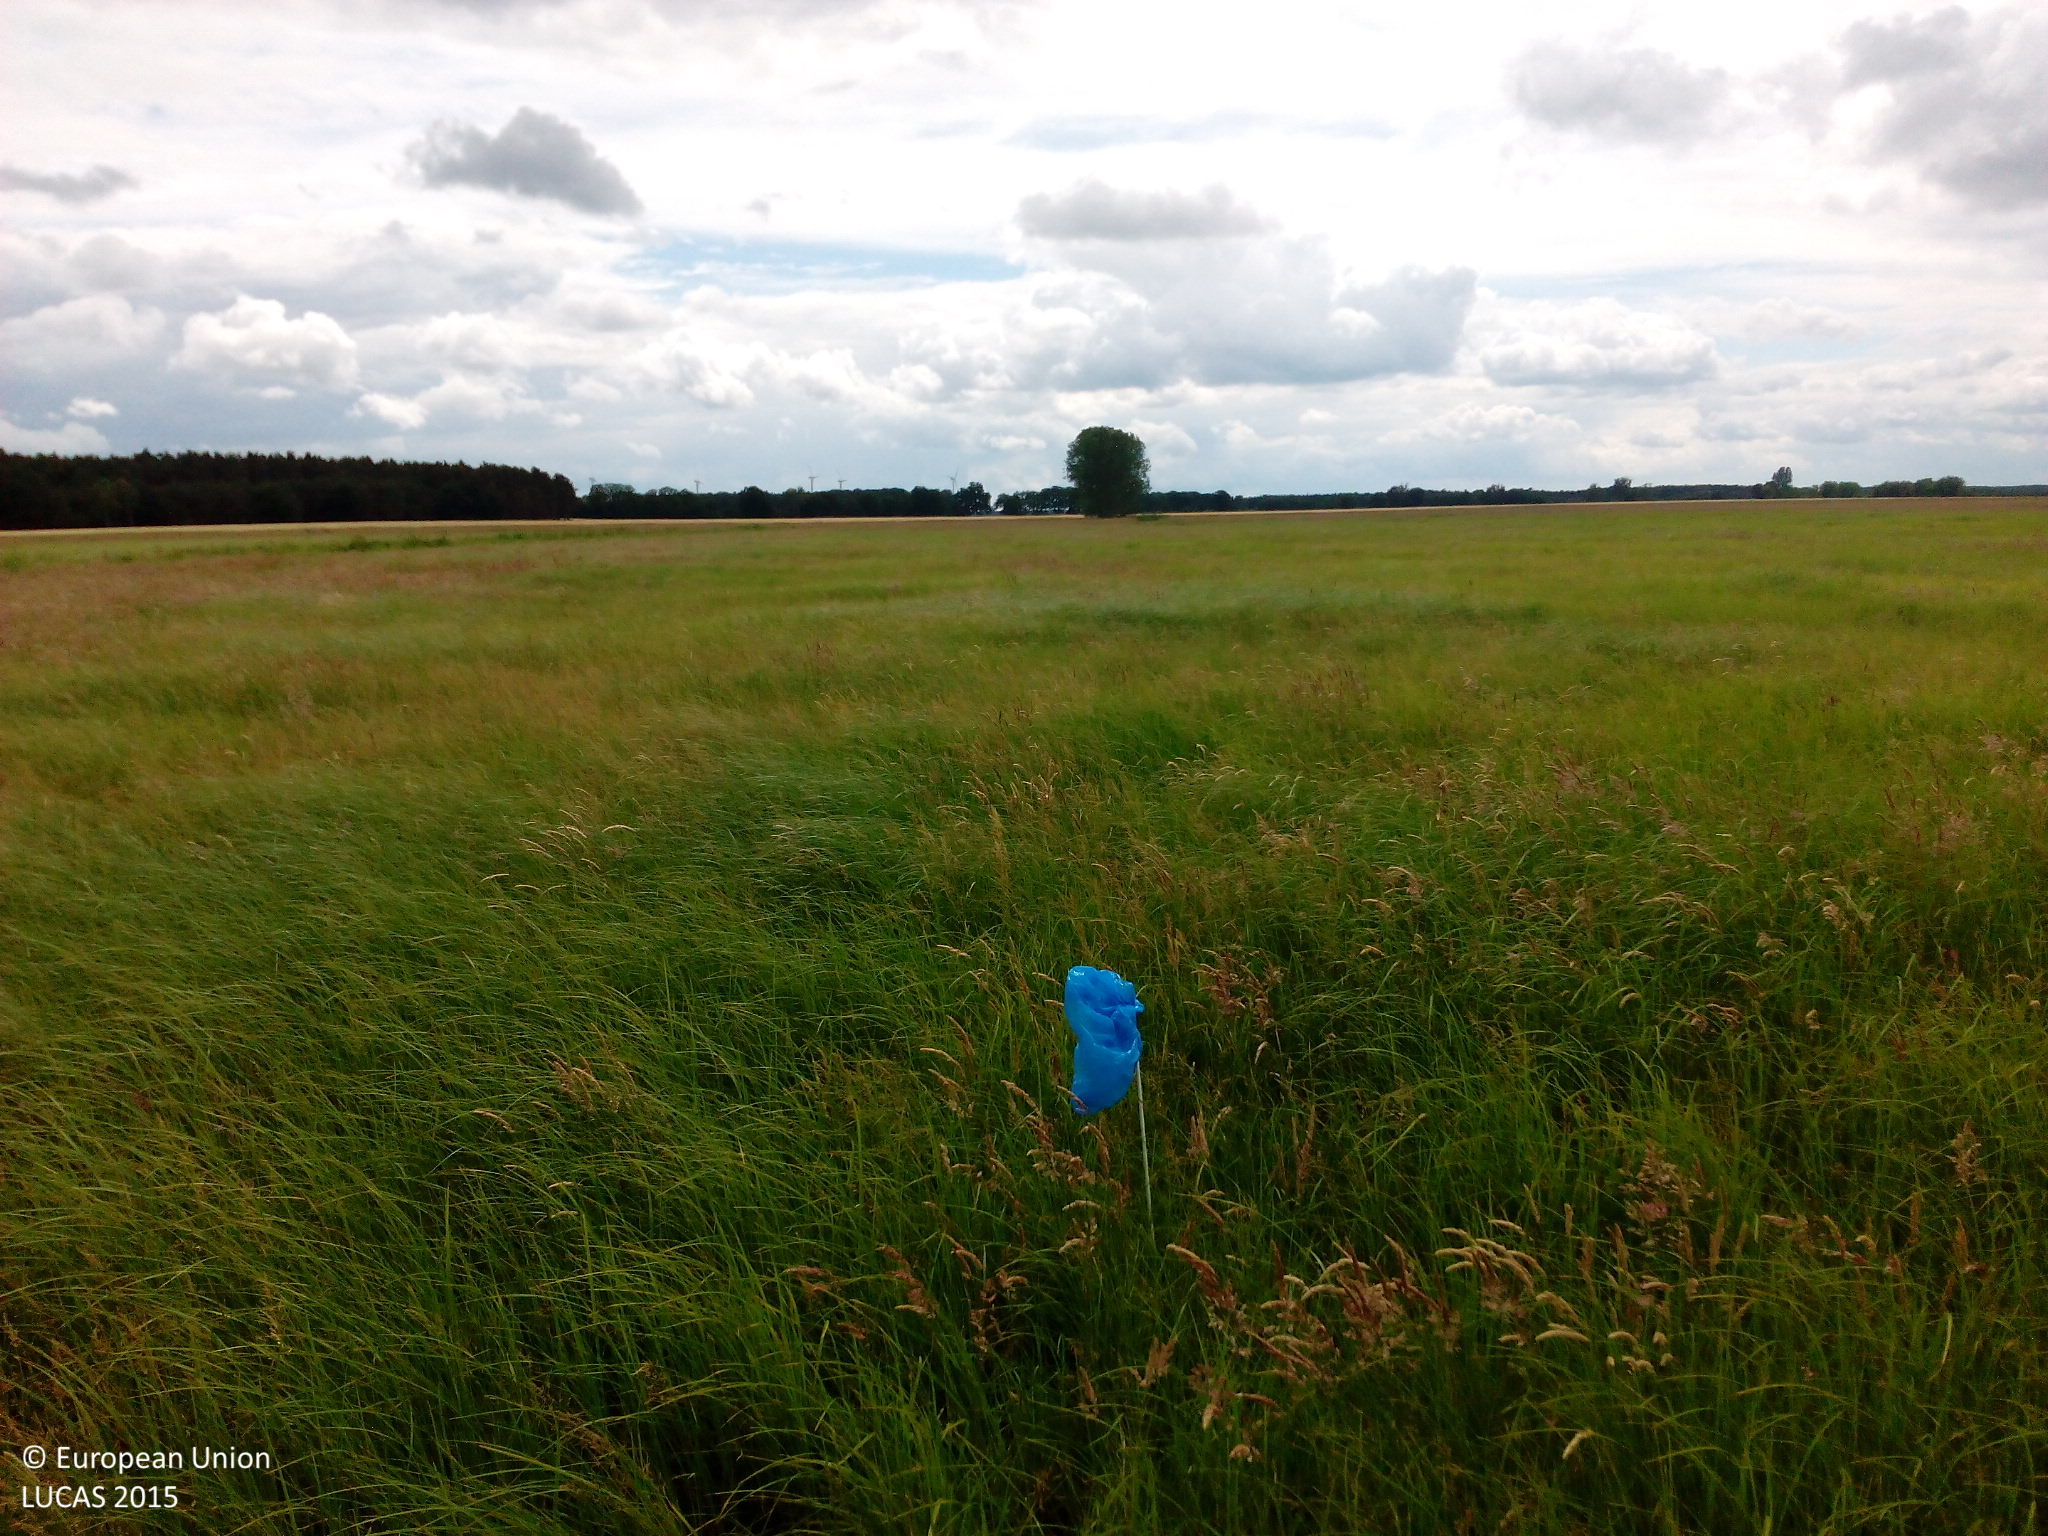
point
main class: Grassland
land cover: Spontaneously vegetated surfaces
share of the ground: > 75 %
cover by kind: herbaceous plants 100 %
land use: Semi-natural and natural areas not in use
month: June
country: DE
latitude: 52.4965
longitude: 12.4300
